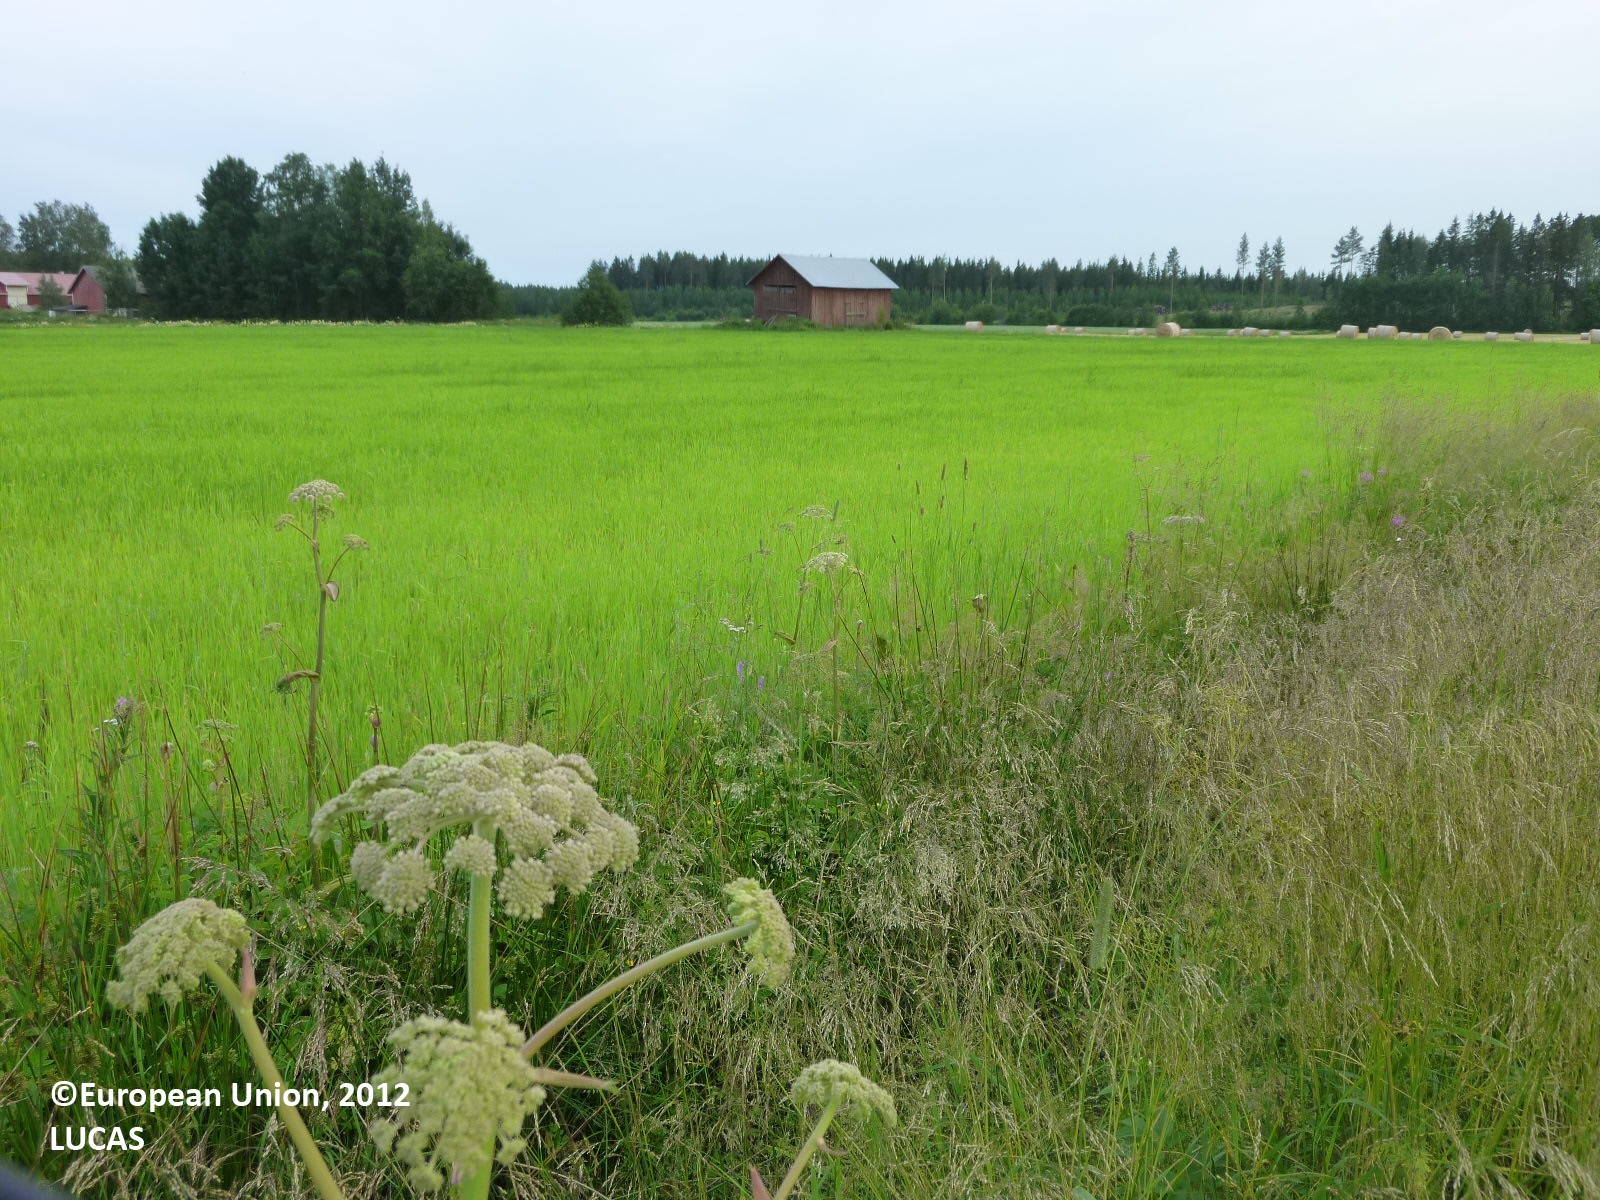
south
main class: Cropland
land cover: Common wheat
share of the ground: > 75 %
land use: Agriculture (excluding fallow land and kitchen gardens)
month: July
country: FI
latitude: 61.4156
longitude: 22.0299
